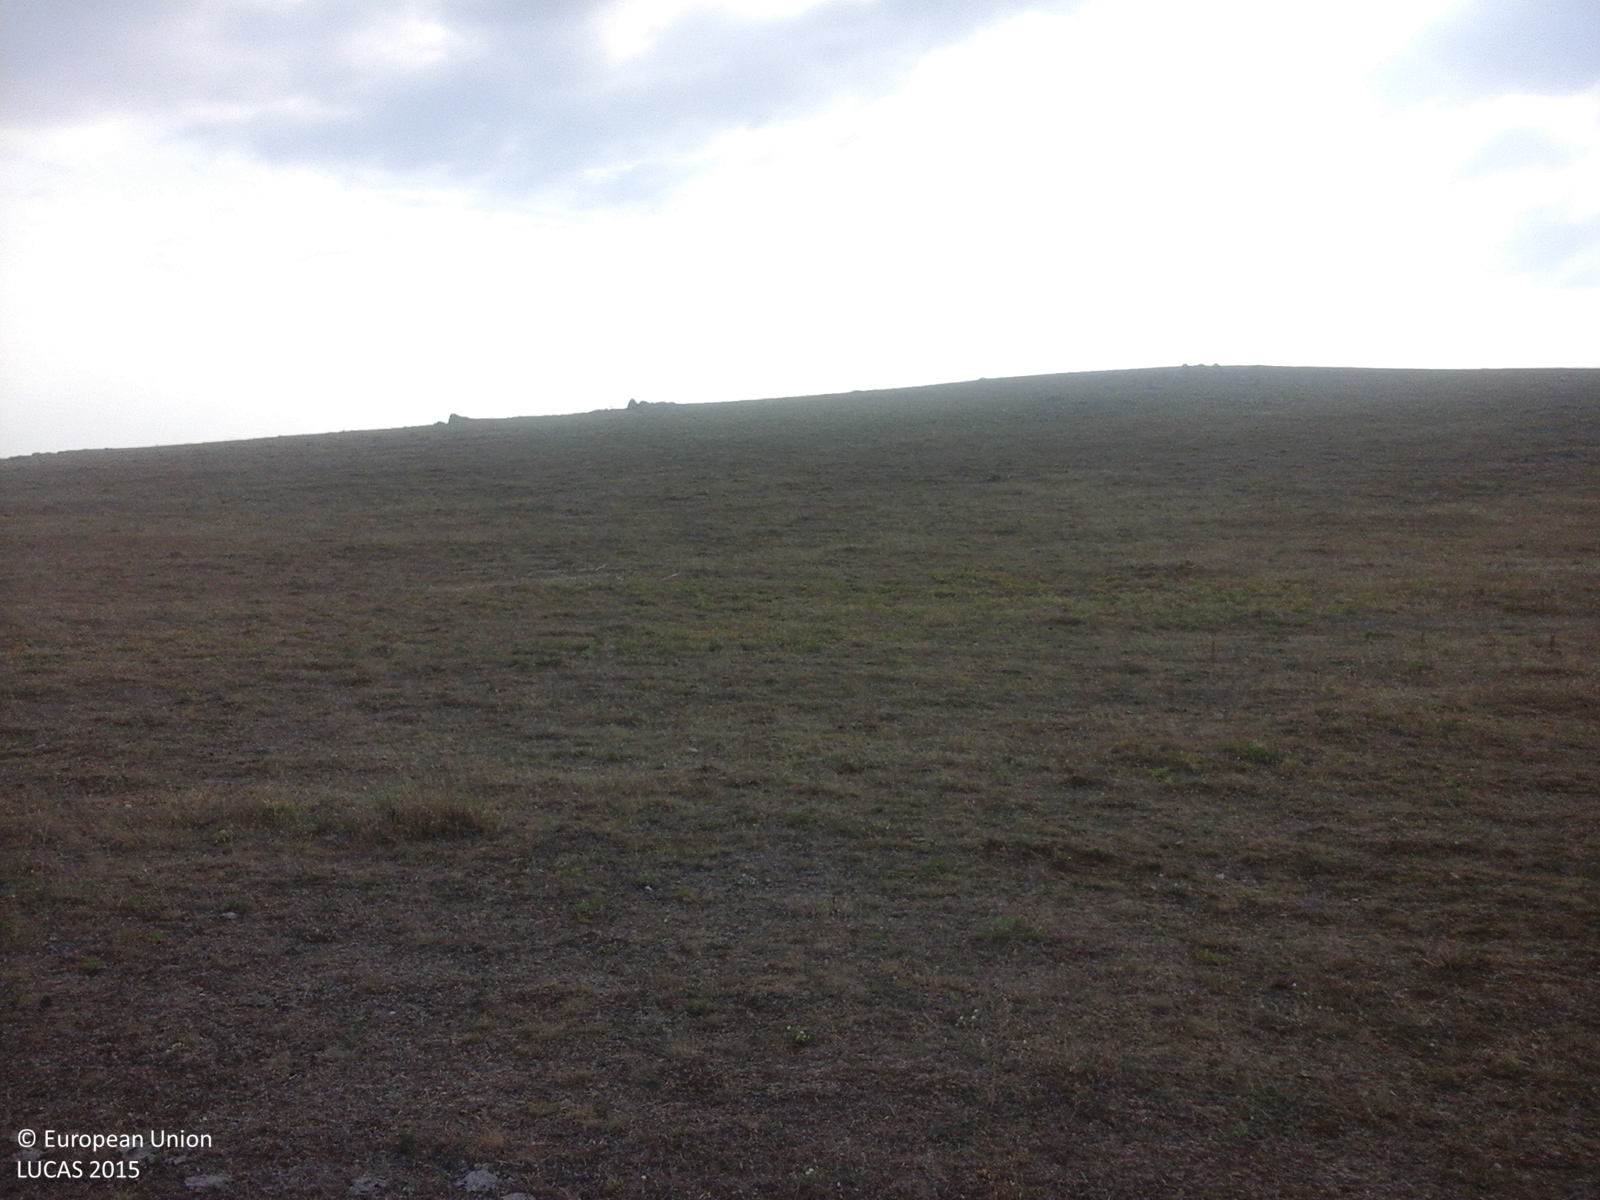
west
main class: Grassland
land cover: Grassland without tree/shrub cover
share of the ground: > 75 %
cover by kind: herbaceous plants 100 %
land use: Agriculture (excluding fallow land and kitchen gardens)
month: July
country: RO
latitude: 45.0600
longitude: 28.3478
